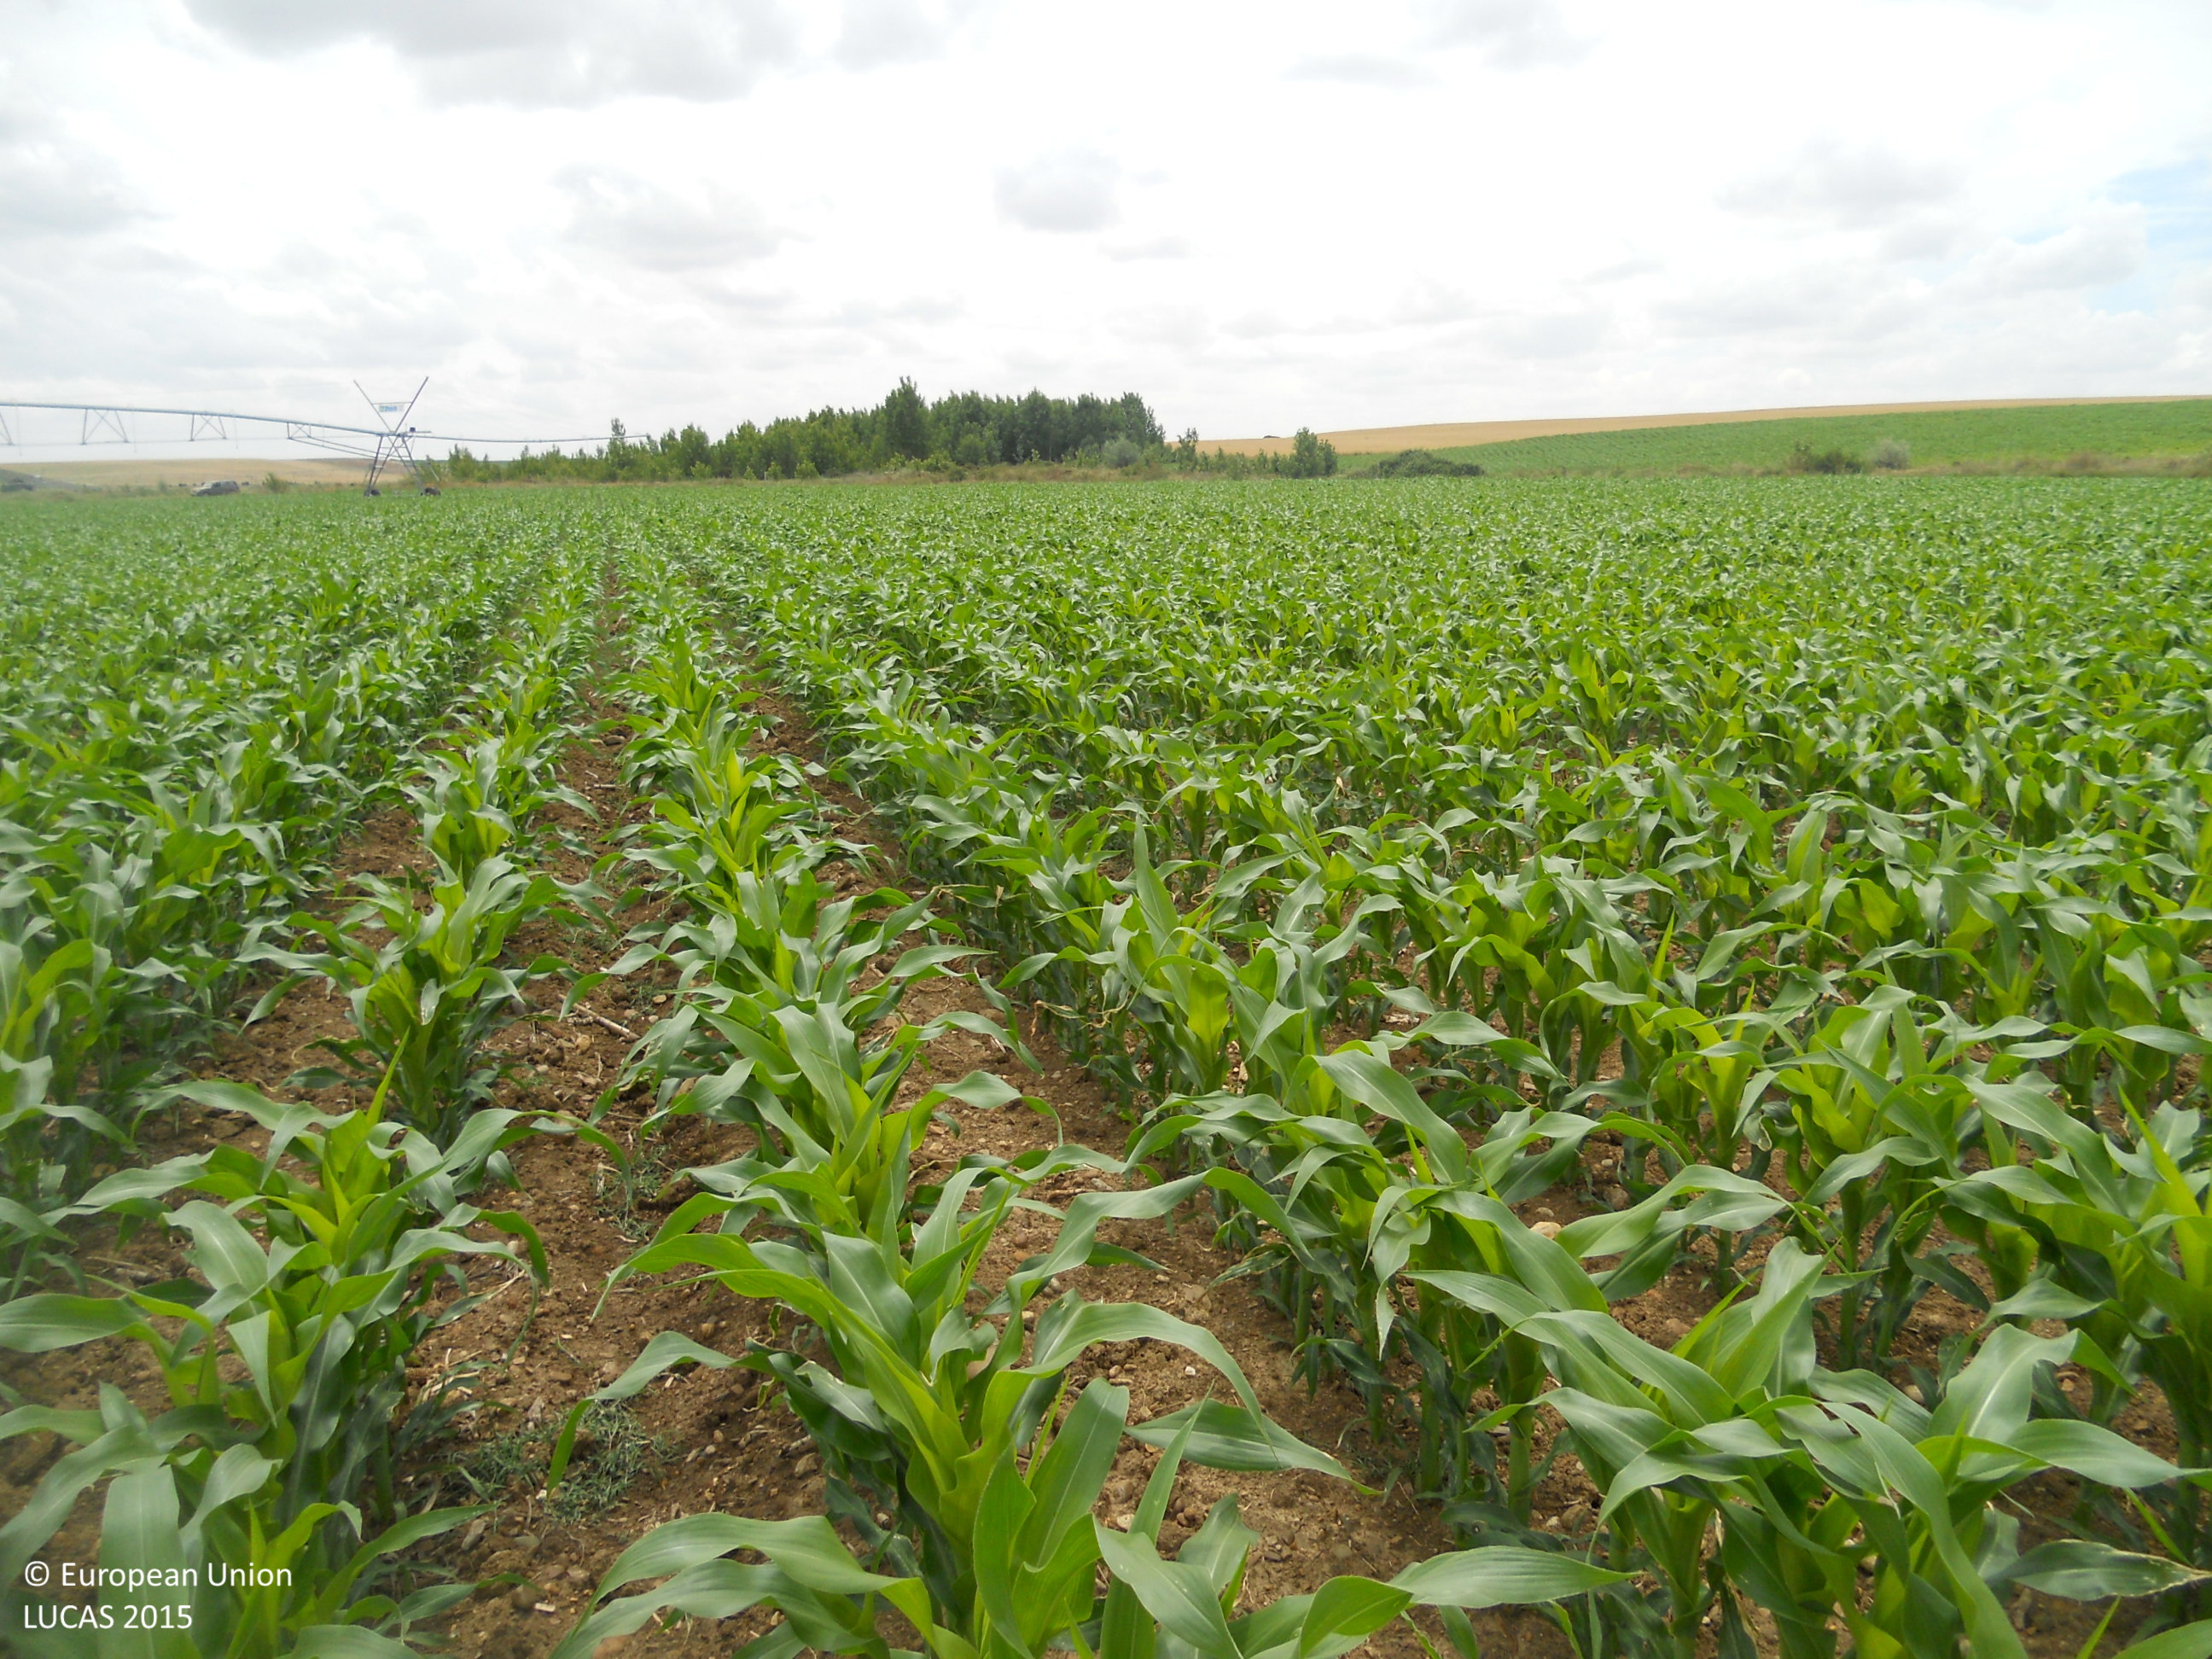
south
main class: Cropland
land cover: Maize
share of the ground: > 75 %
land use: Agriculture (excluding fallow land and kitchen gardens)
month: June
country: ES
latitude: 42.2969
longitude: -5.2610
